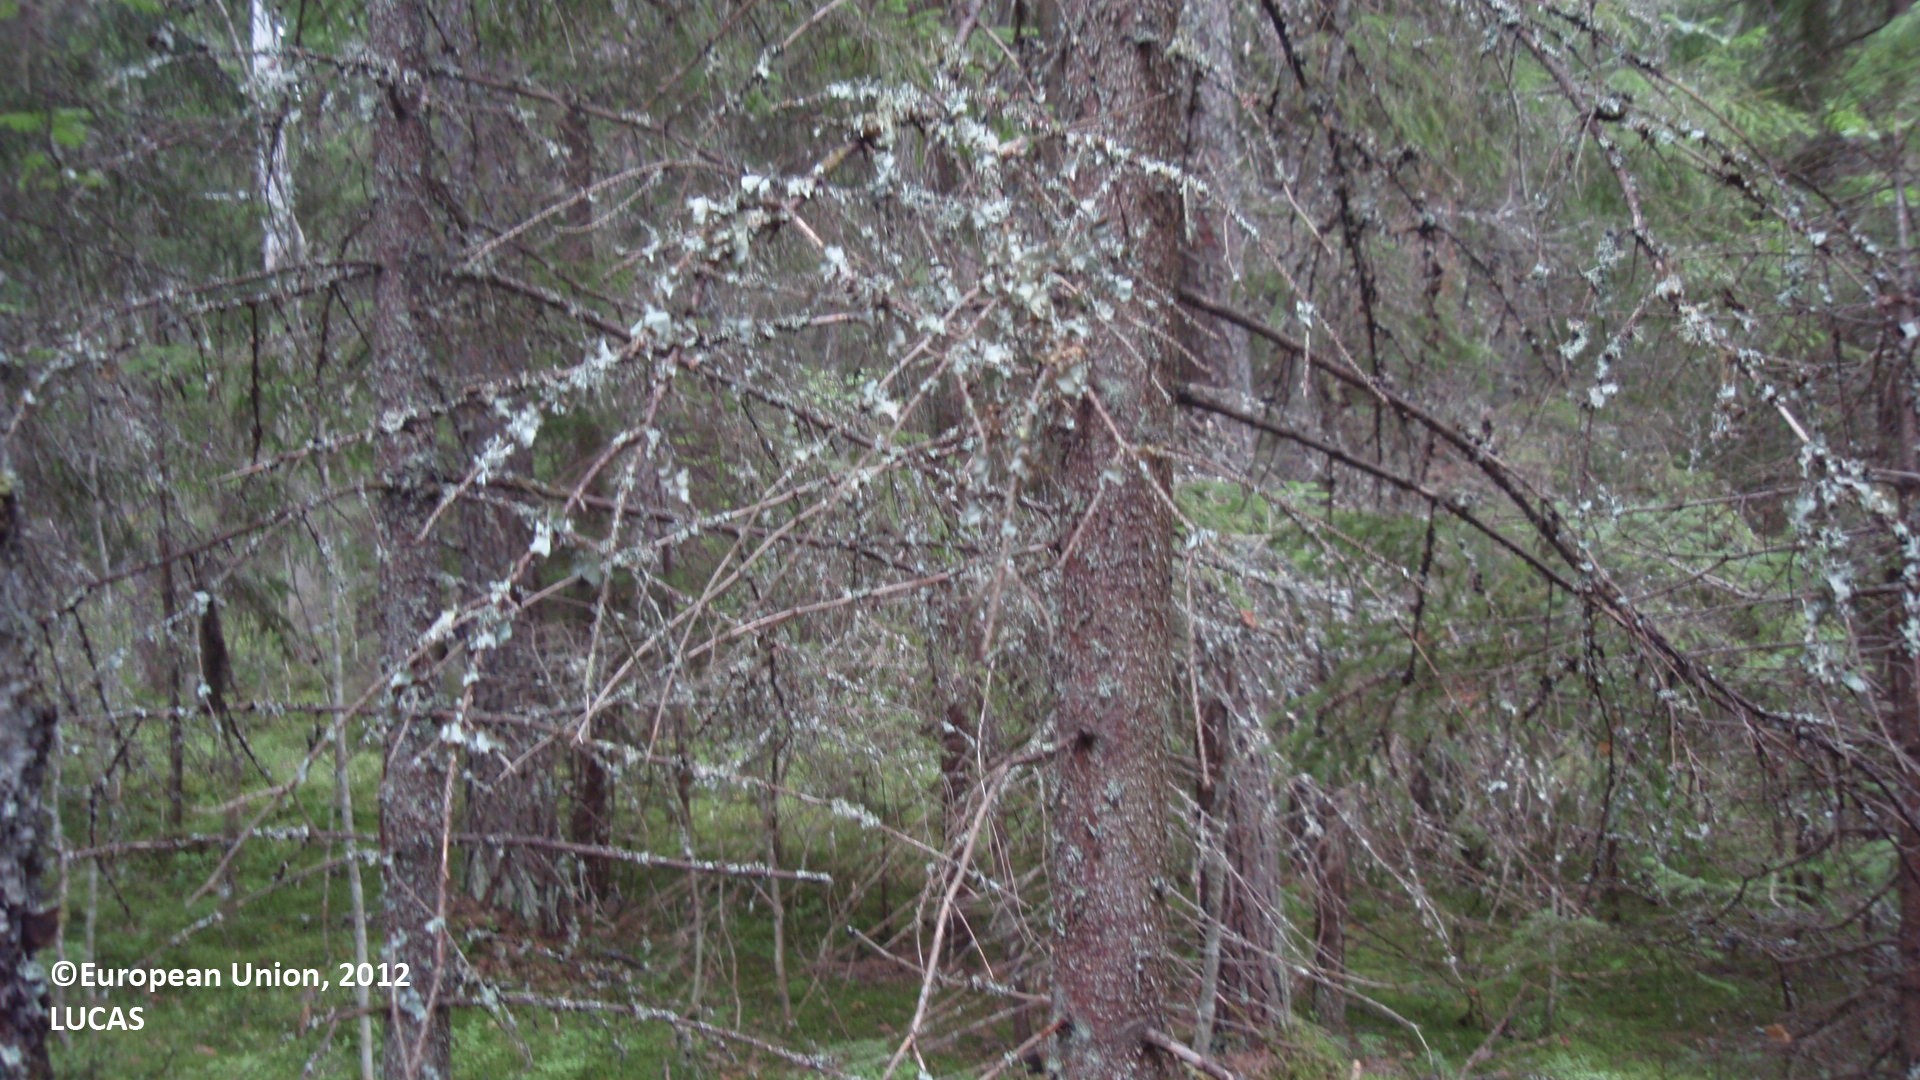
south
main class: Woodland
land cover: Spruce dominated mixed woodland
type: boreal forest
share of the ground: 50 - 75 %
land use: Forestry
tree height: > 5 m
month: August
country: FI
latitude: 60.8375
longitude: 27.4571
